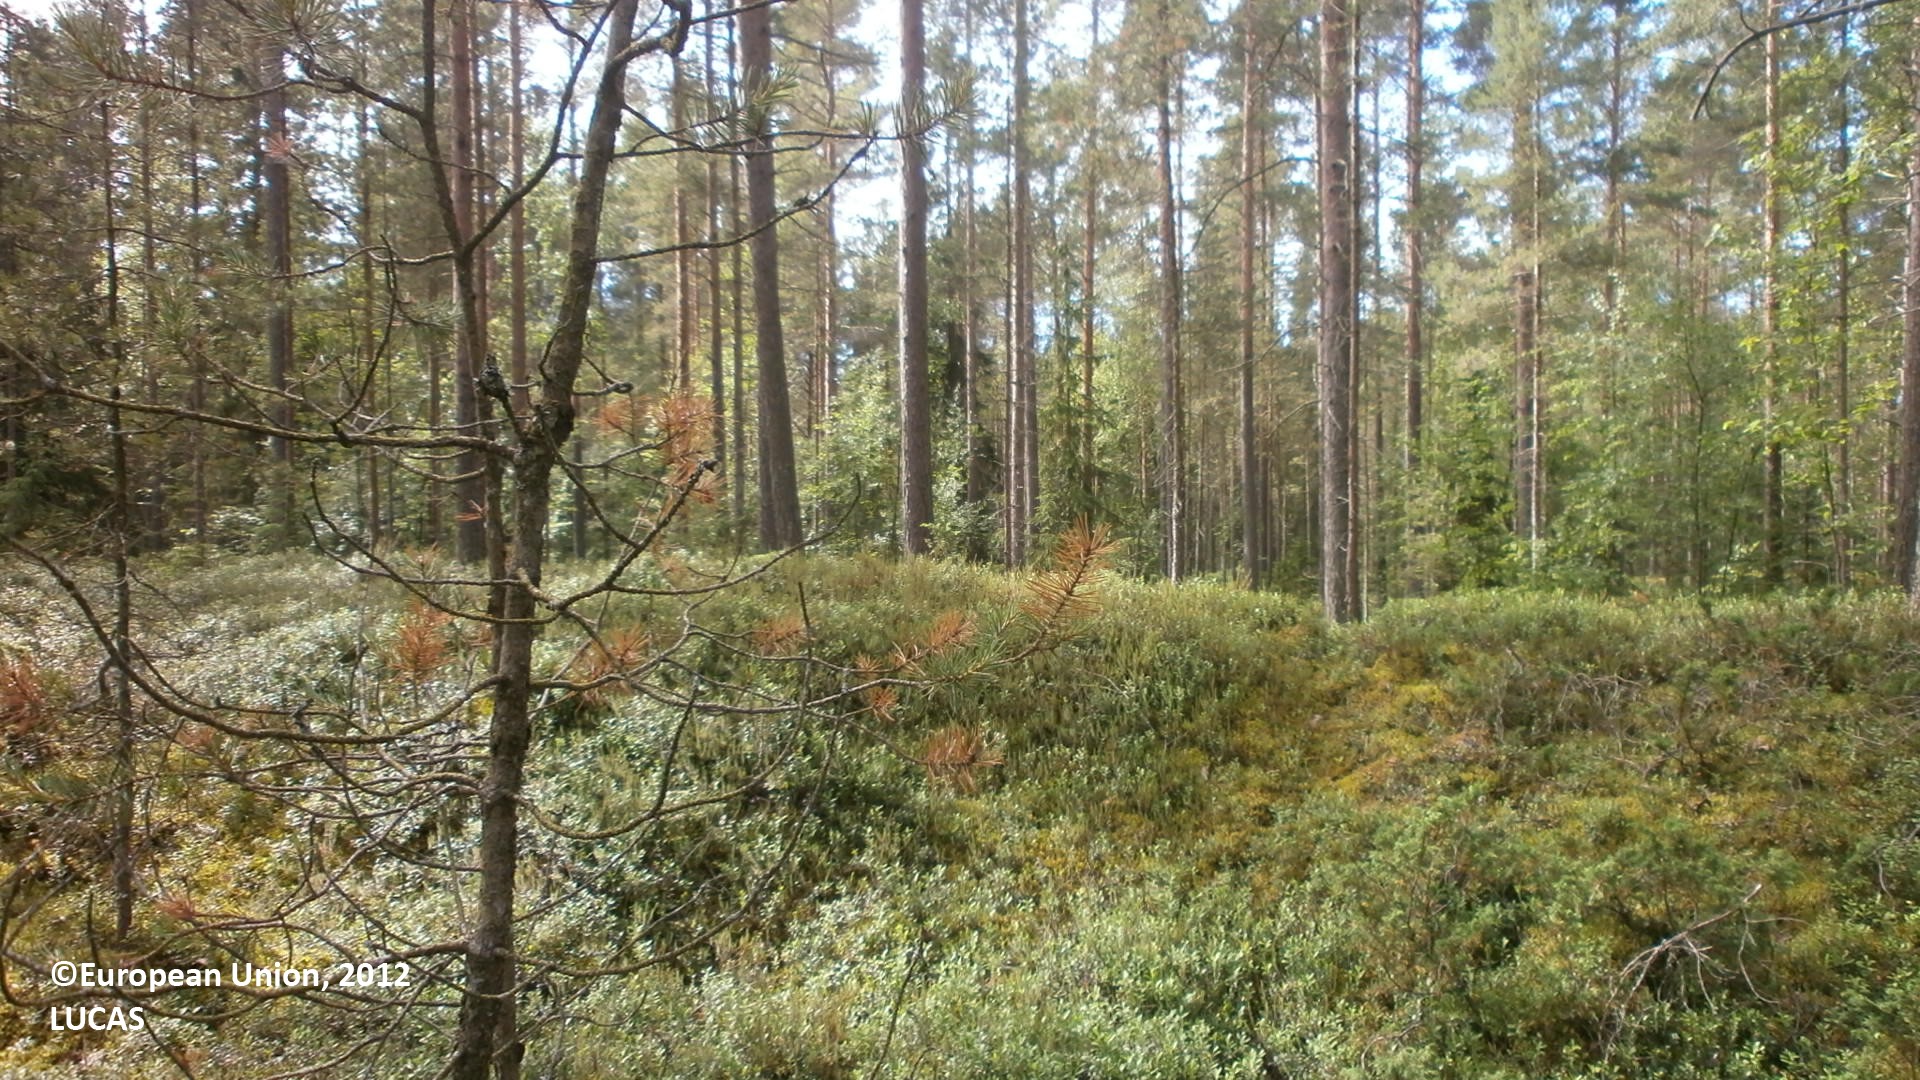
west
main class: Woodland
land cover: Pine dominated coniferous woodland
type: boreal forest
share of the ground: 50 - 75 %
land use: Forestry
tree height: > 5 m
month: July
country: FI
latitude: 64.2461
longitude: 23.8601
